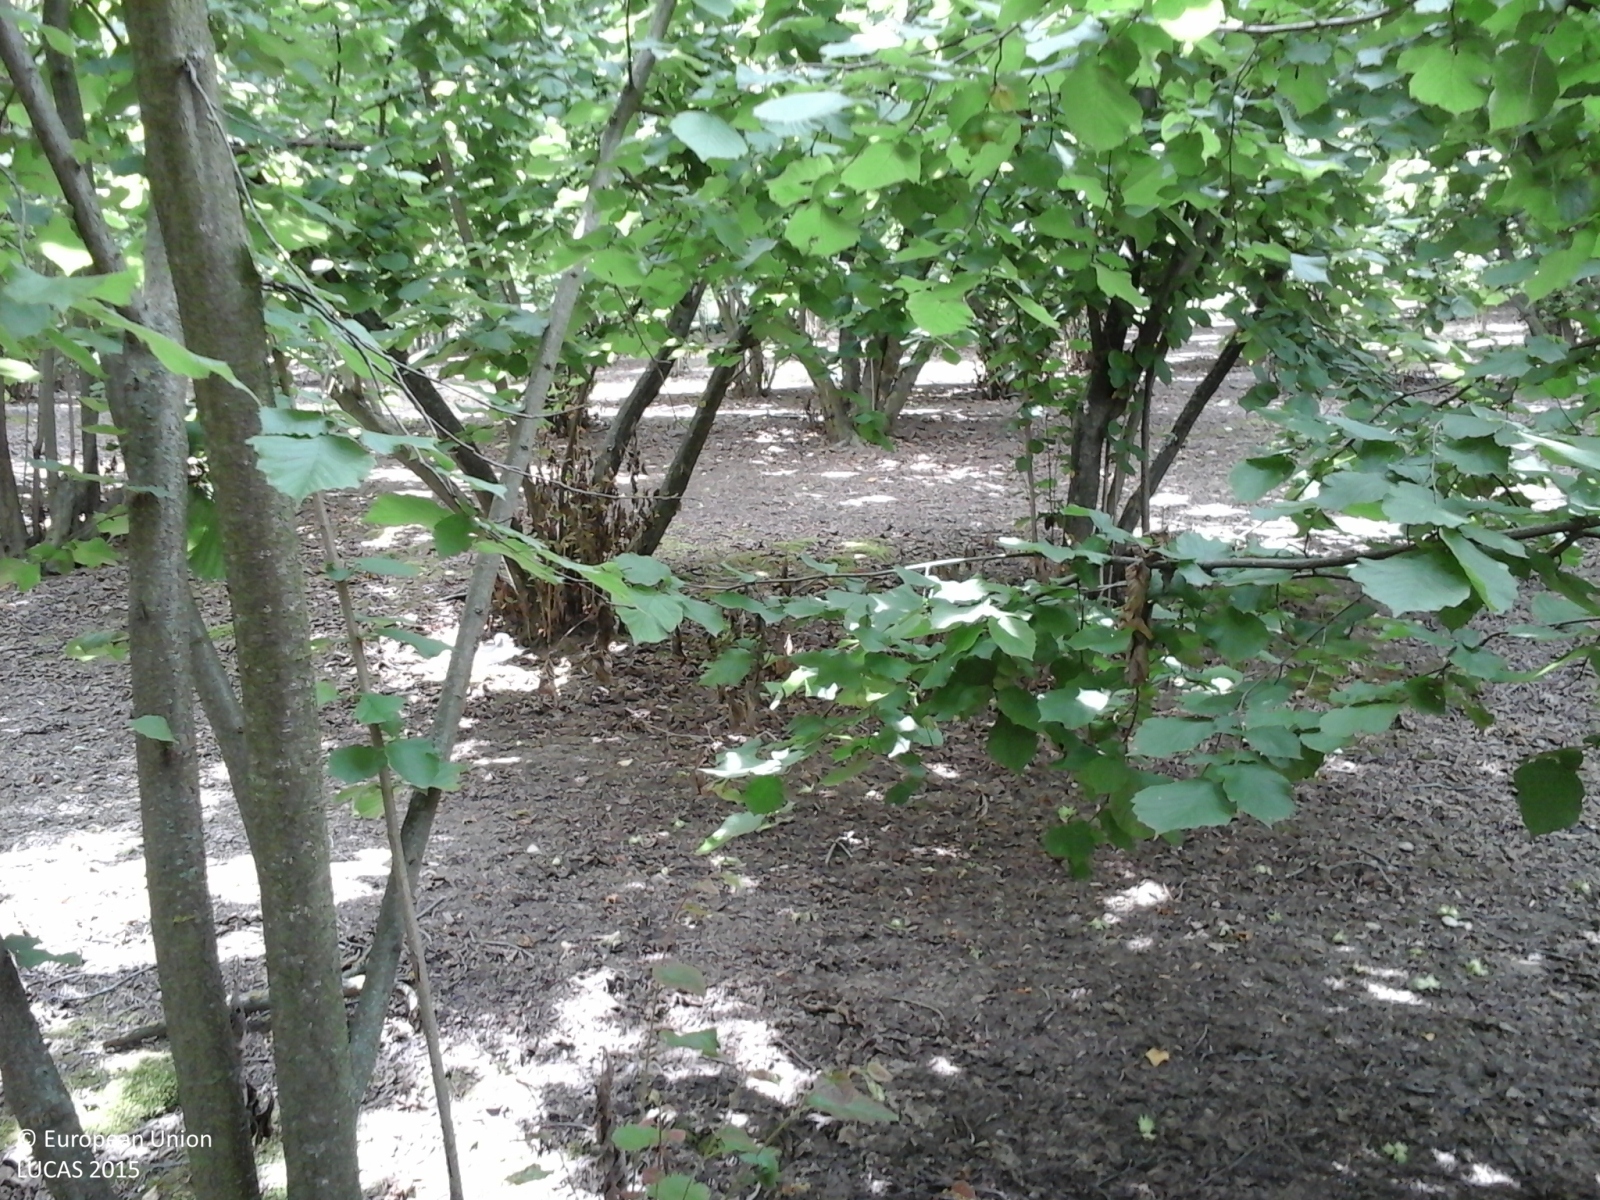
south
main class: Cropland
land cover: Nuts trees
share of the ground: > 75 %
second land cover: Other bare soil
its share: > 75 %
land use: Agriculture (excluding fallow land and kitchen gardens)
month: June
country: IT
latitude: 44.5844
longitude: 8.0266
